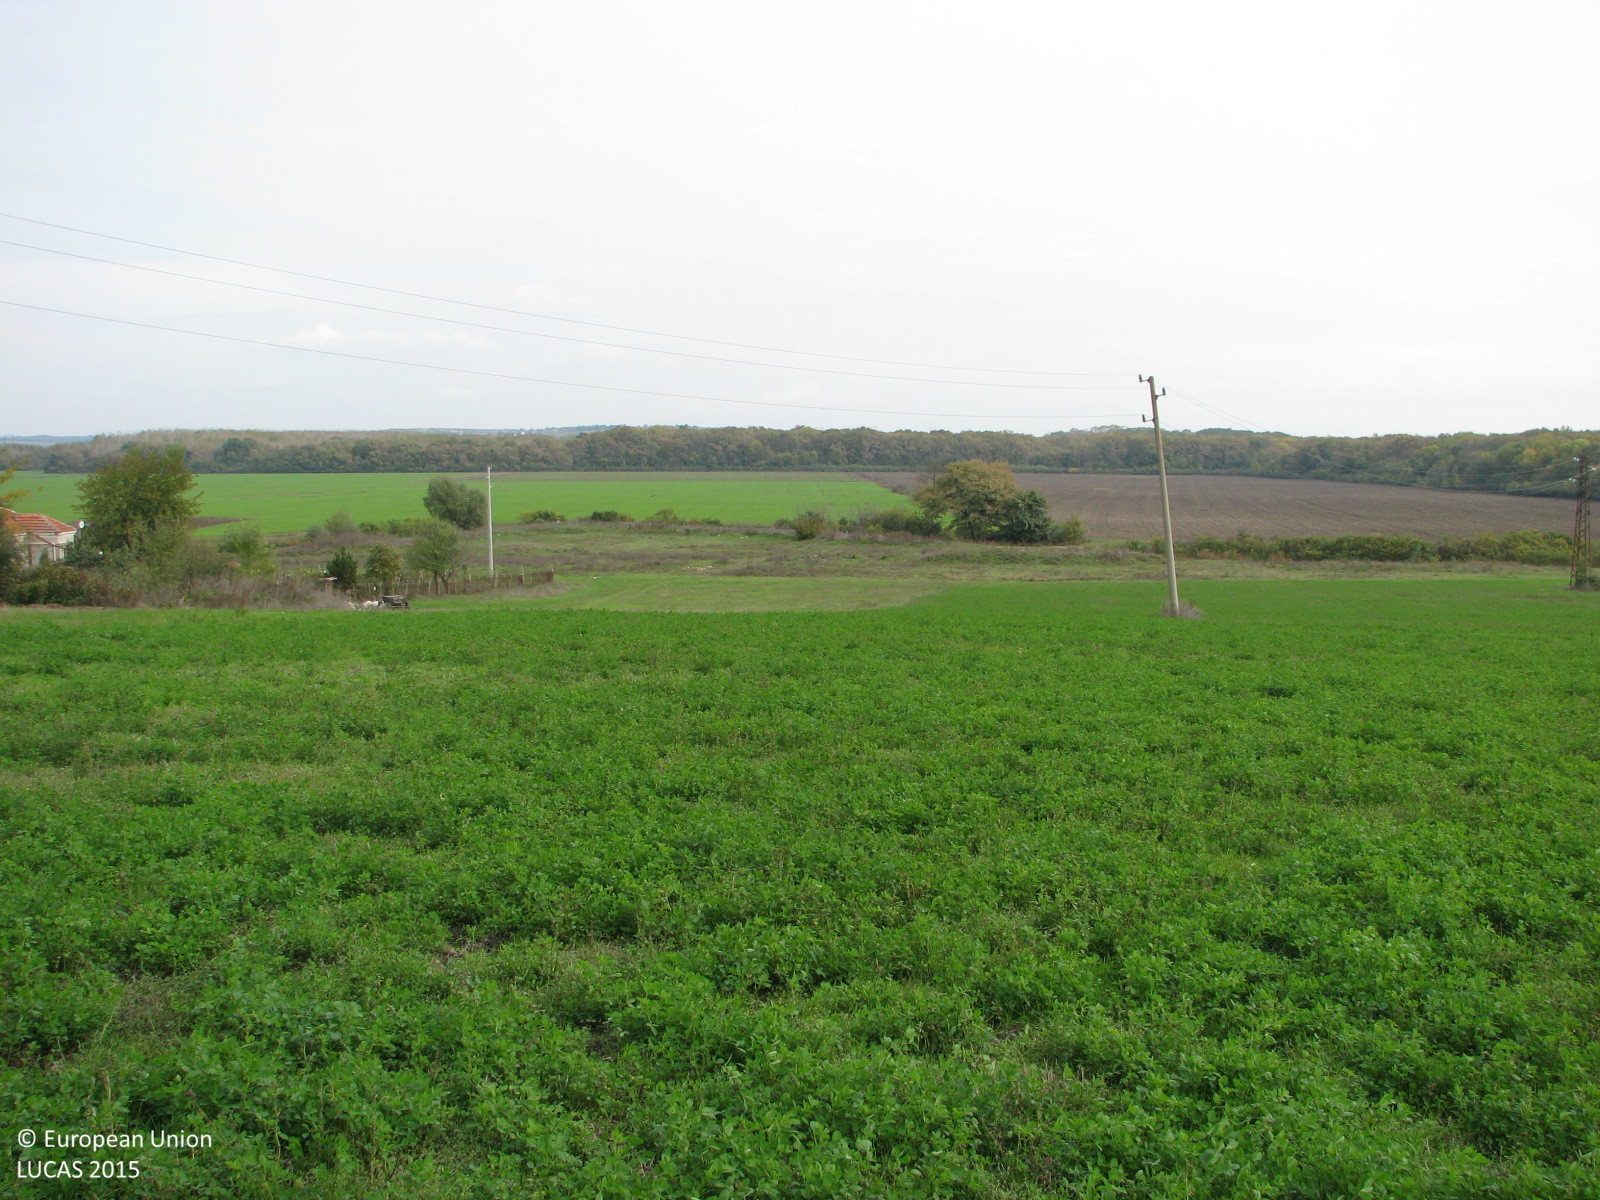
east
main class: Cropland
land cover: Lucerne
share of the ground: > 75 %
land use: Agriculture (excluding fallow land and kitchen gardens)
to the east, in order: Lucerne; Electric lines; Lucerne; Tracks; Grassland without tree/shrub cover; Tracks; Grassland without tree/shrub cover
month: October
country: BG
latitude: 42.2191
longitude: 26.5534
